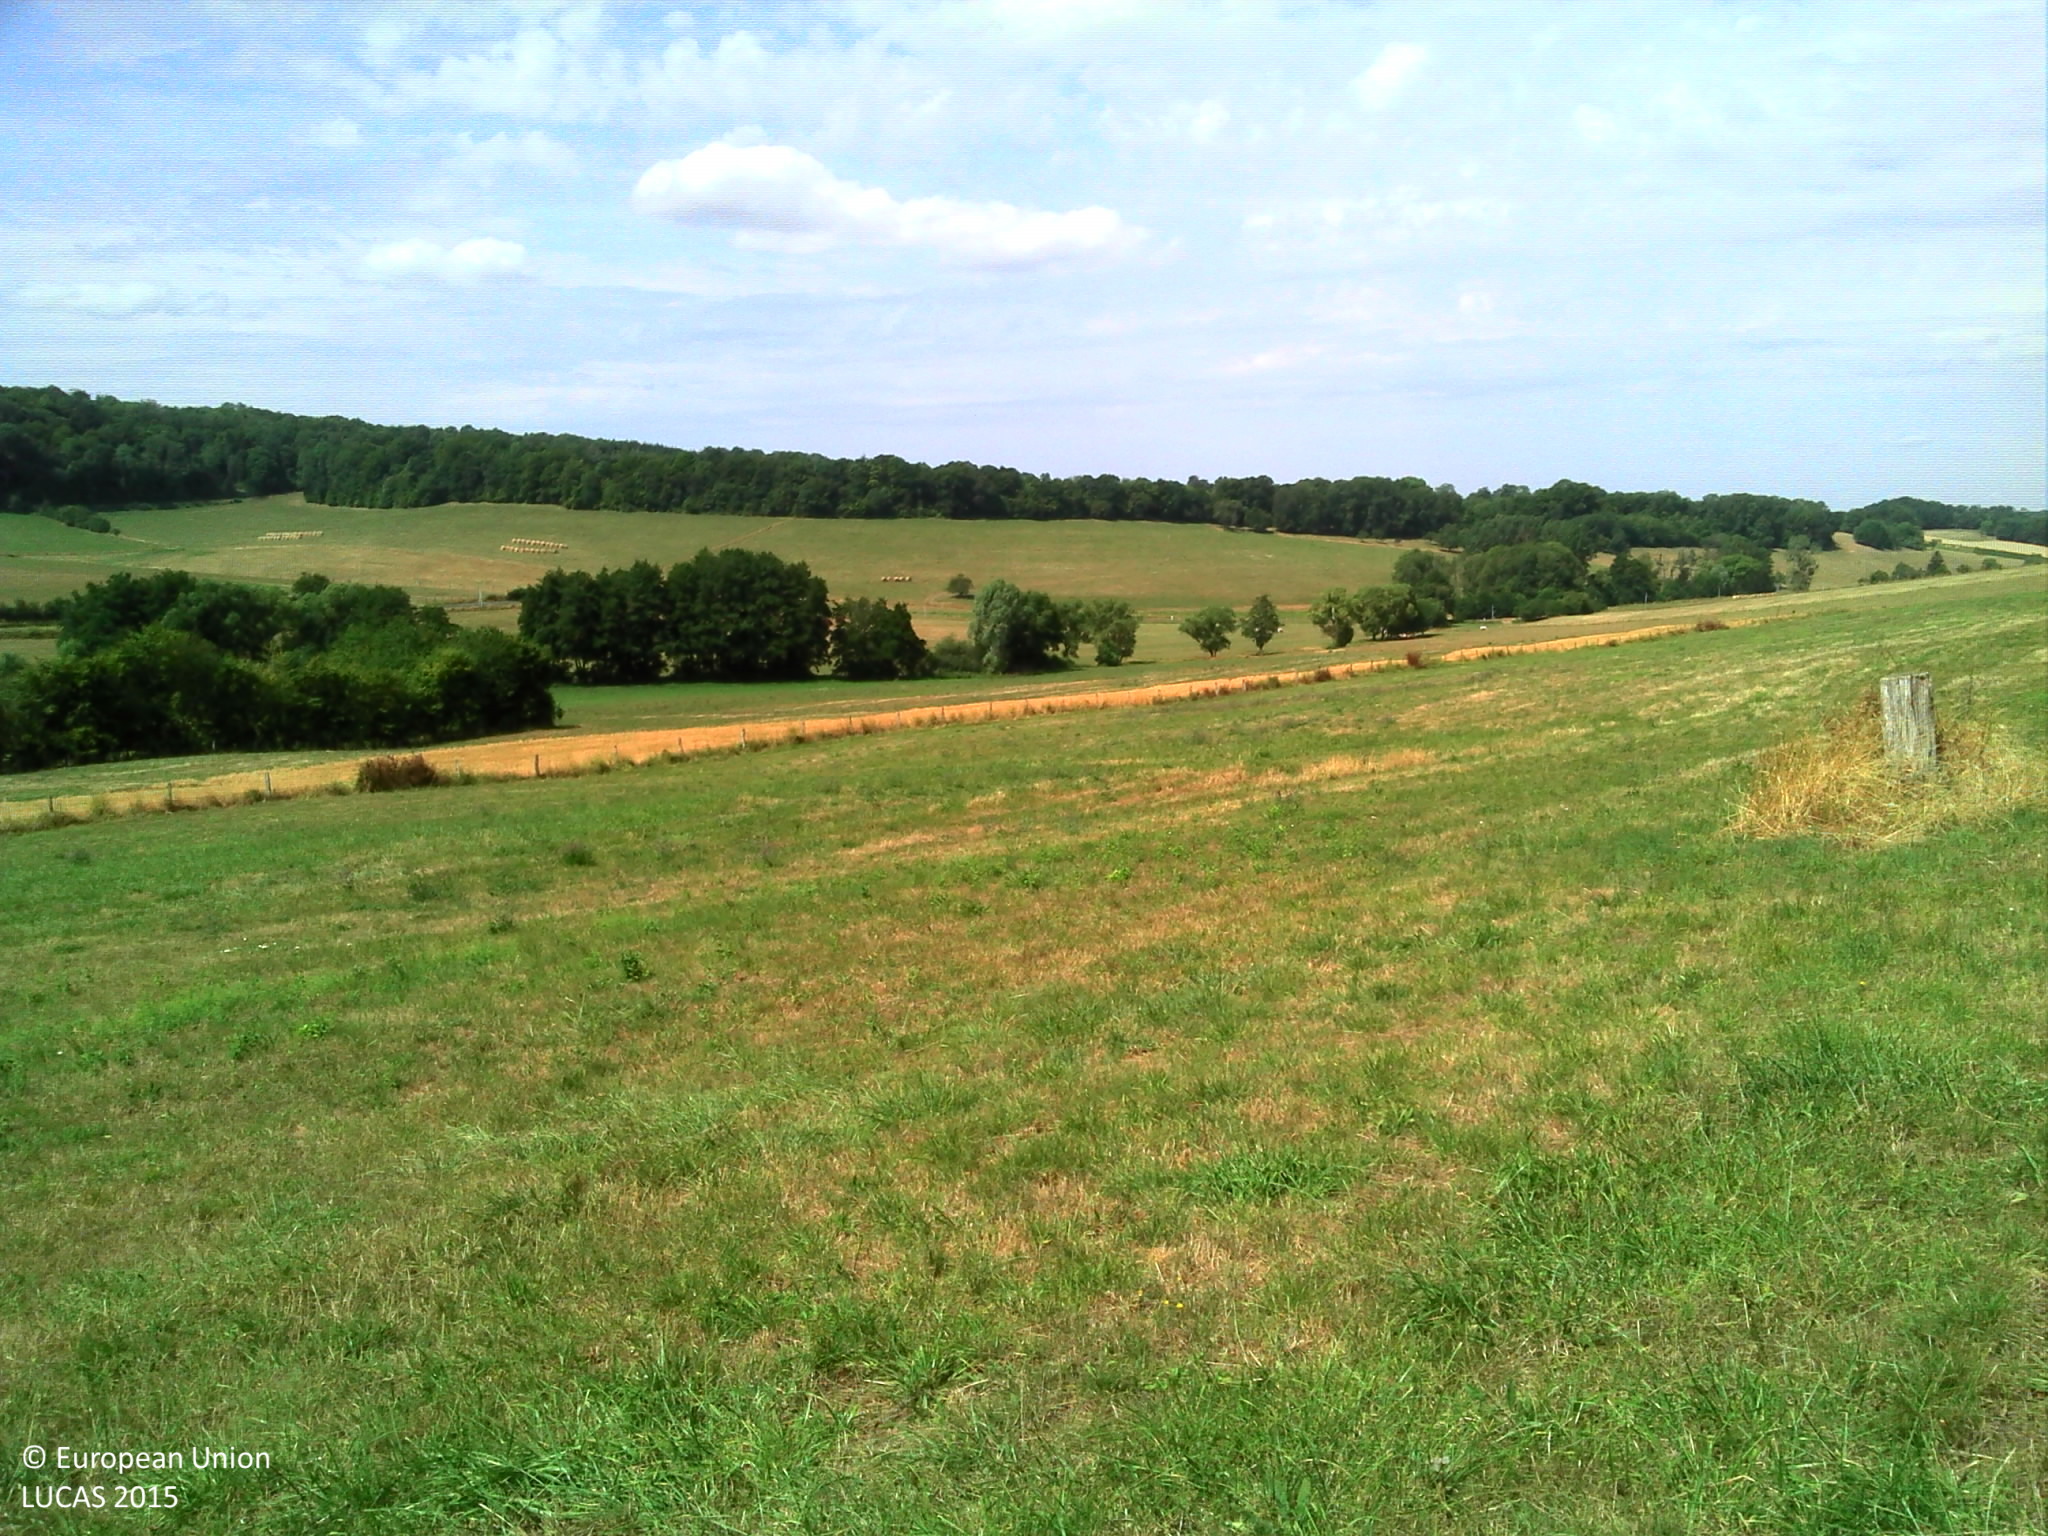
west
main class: Grassland
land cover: Grassland with sparse tree/shrub cover
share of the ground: > 75 %
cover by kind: herbaceous plants 95 %, broadleaved forest trees 5 %
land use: Agriculture (excluding fallow land and kitchen gardens)
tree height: > 5 m
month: July
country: FR
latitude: 48.4018
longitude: 5.9613
